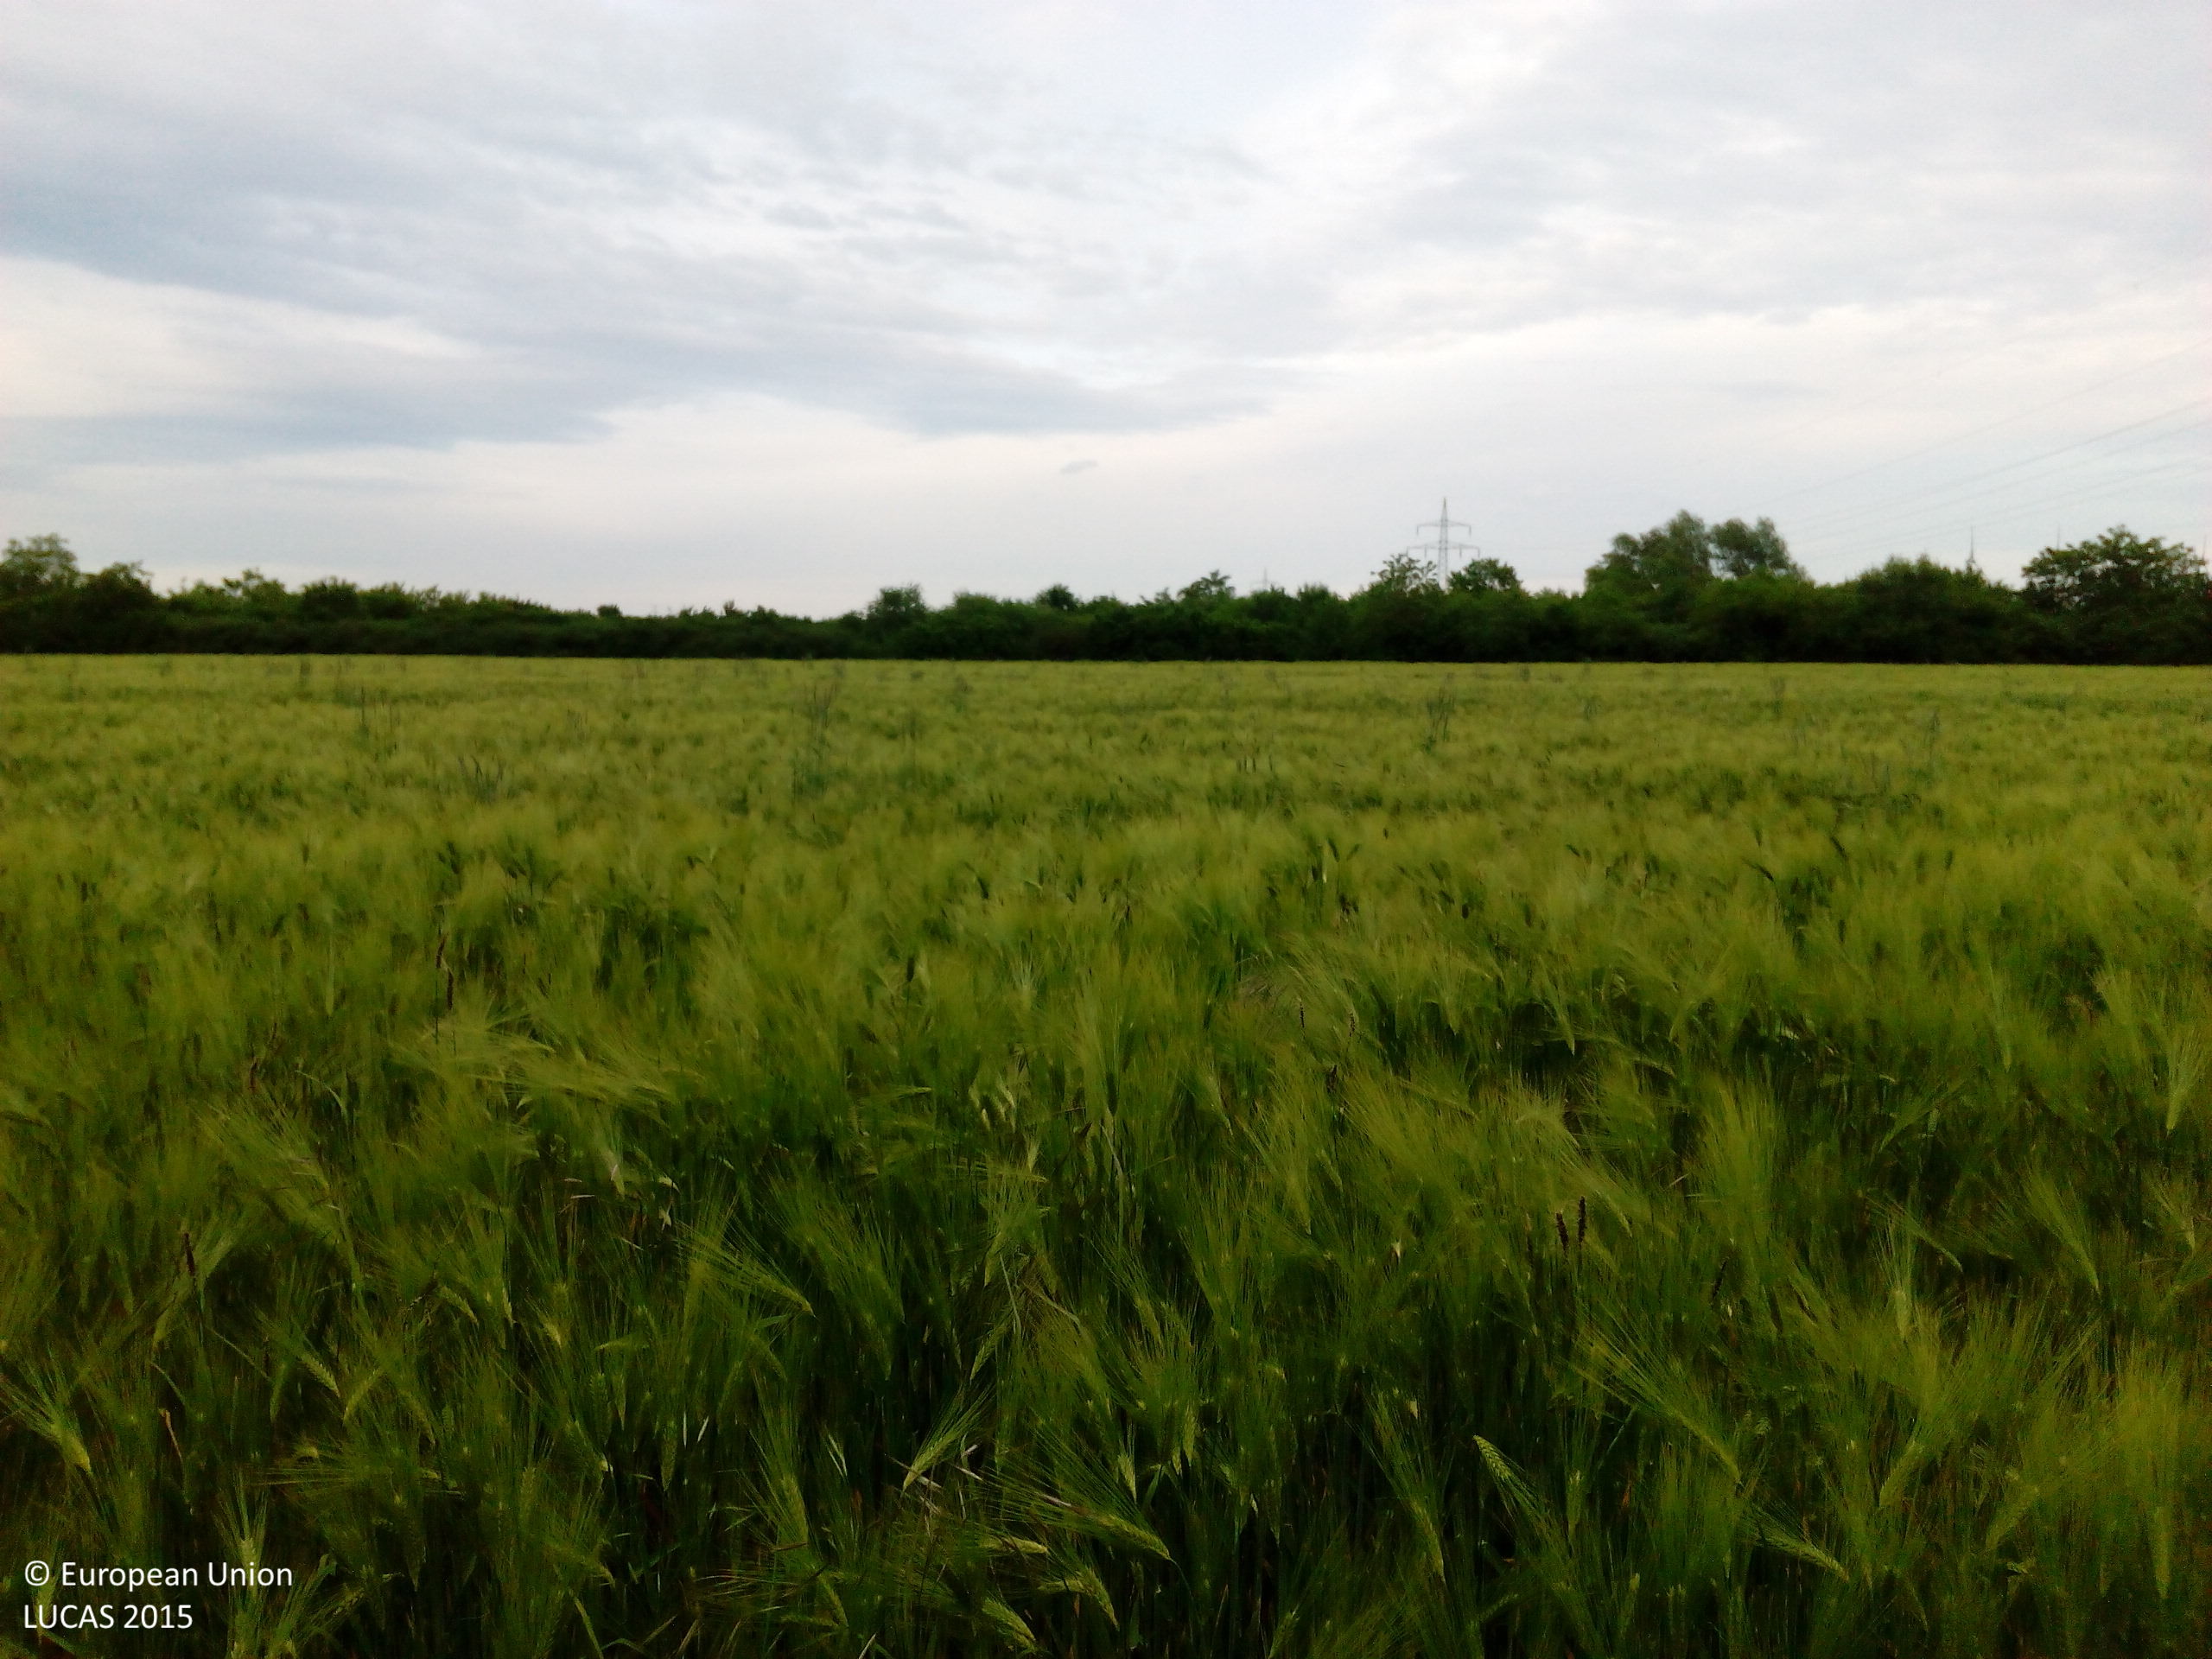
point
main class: Cropland
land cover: Barley
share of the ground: > 75 %
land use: Agriculture (excluding fallow land and kitchen gardens)
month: May
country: DE
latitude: 51.7275
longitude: 12.2148
